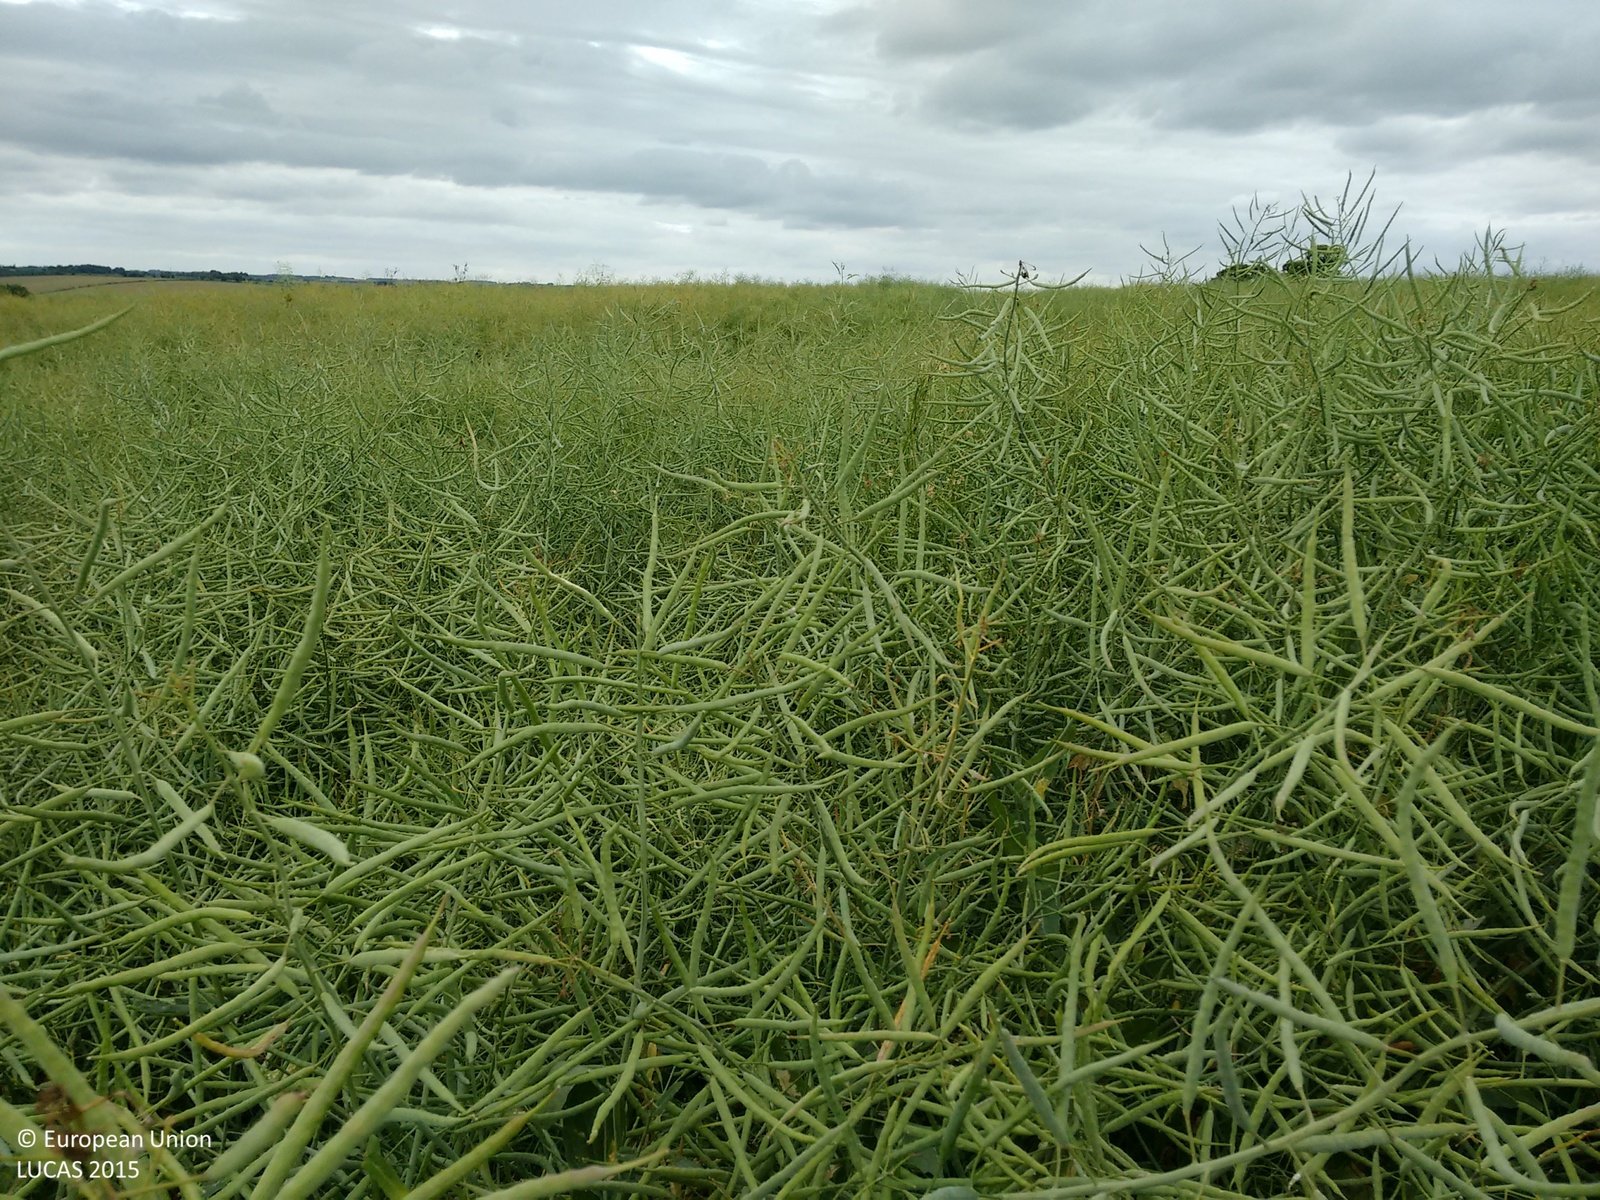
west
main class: Cropland
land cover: Rape and turnip rape
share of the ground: > 75 %
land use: Agriculture (excluding fallow land and kitchen gardens)
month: July
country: GB
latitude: 51.8082
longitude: -1.5828
